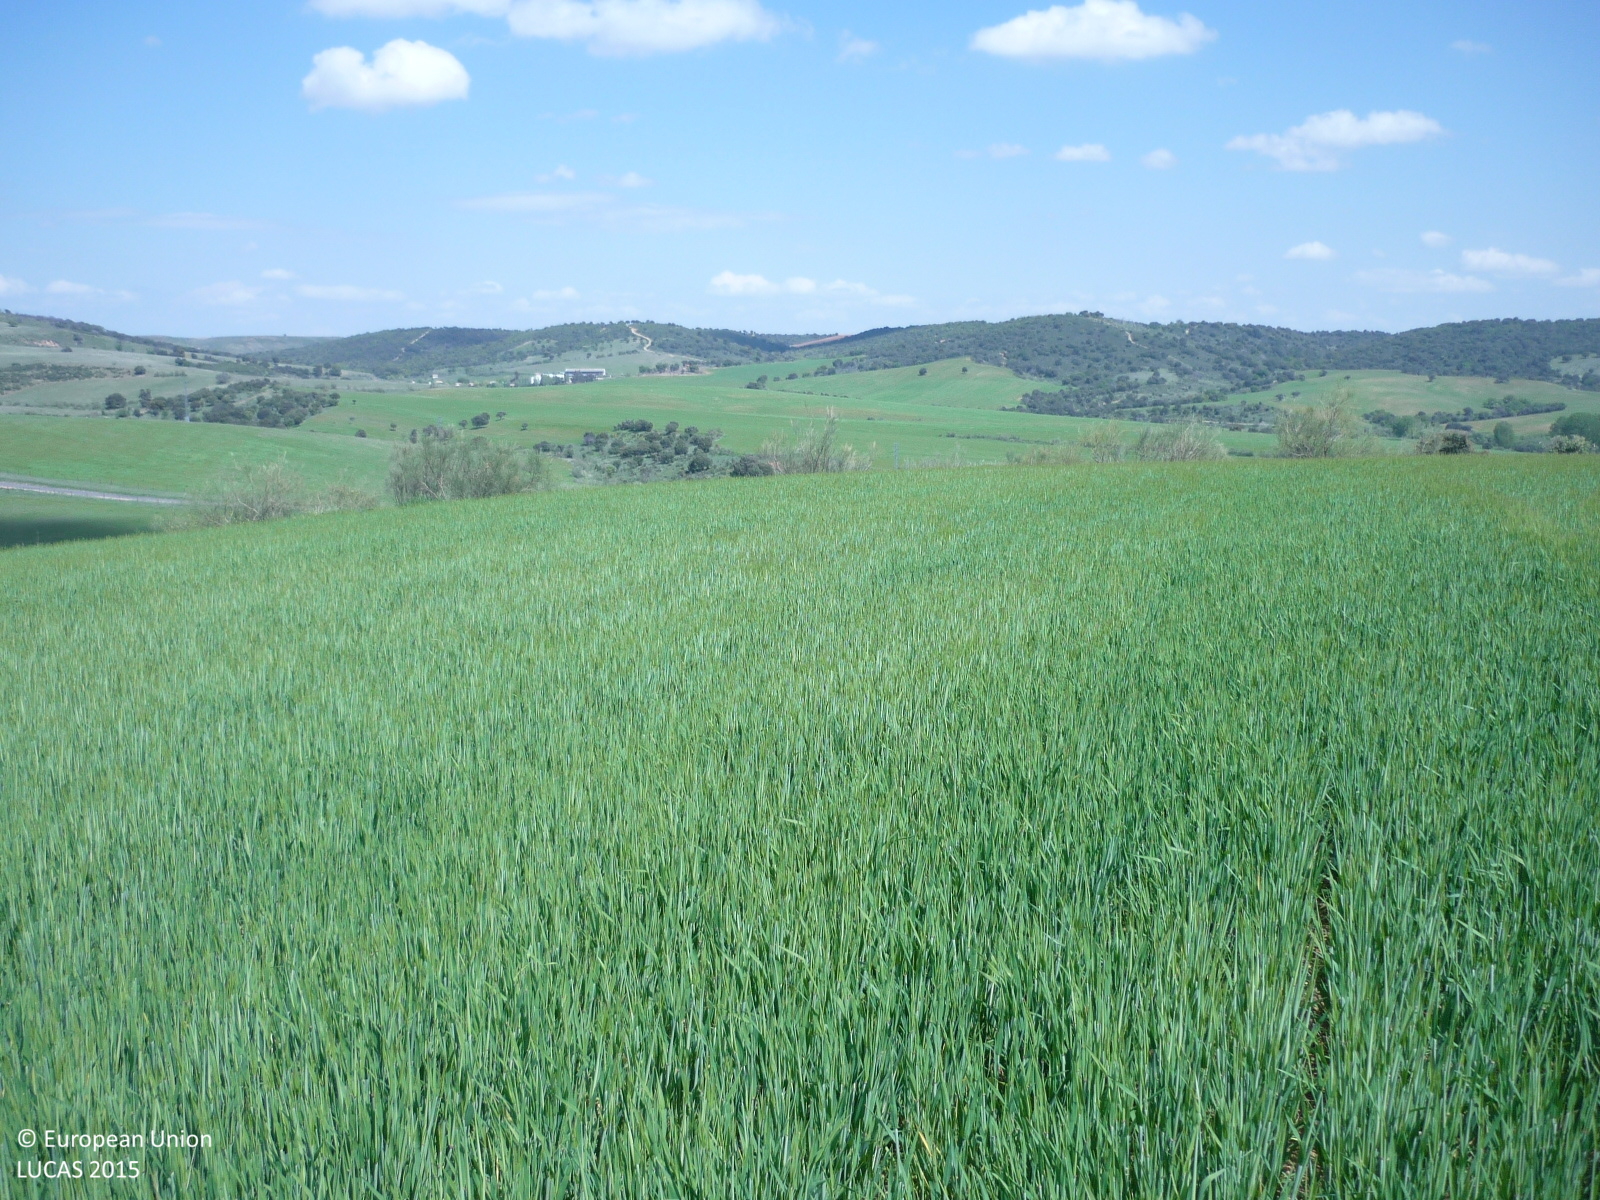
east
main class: Cropland
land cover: Barley
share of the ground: > 75 %
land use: Agriculture (excluding fallow land and kitchen gardens)
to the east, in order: Barley; Shrubland with sparse tree cover; Barley; Tracks; Grass margins; Other bare soil
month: April
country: ES
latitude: 40.7809
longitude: -3.4643
